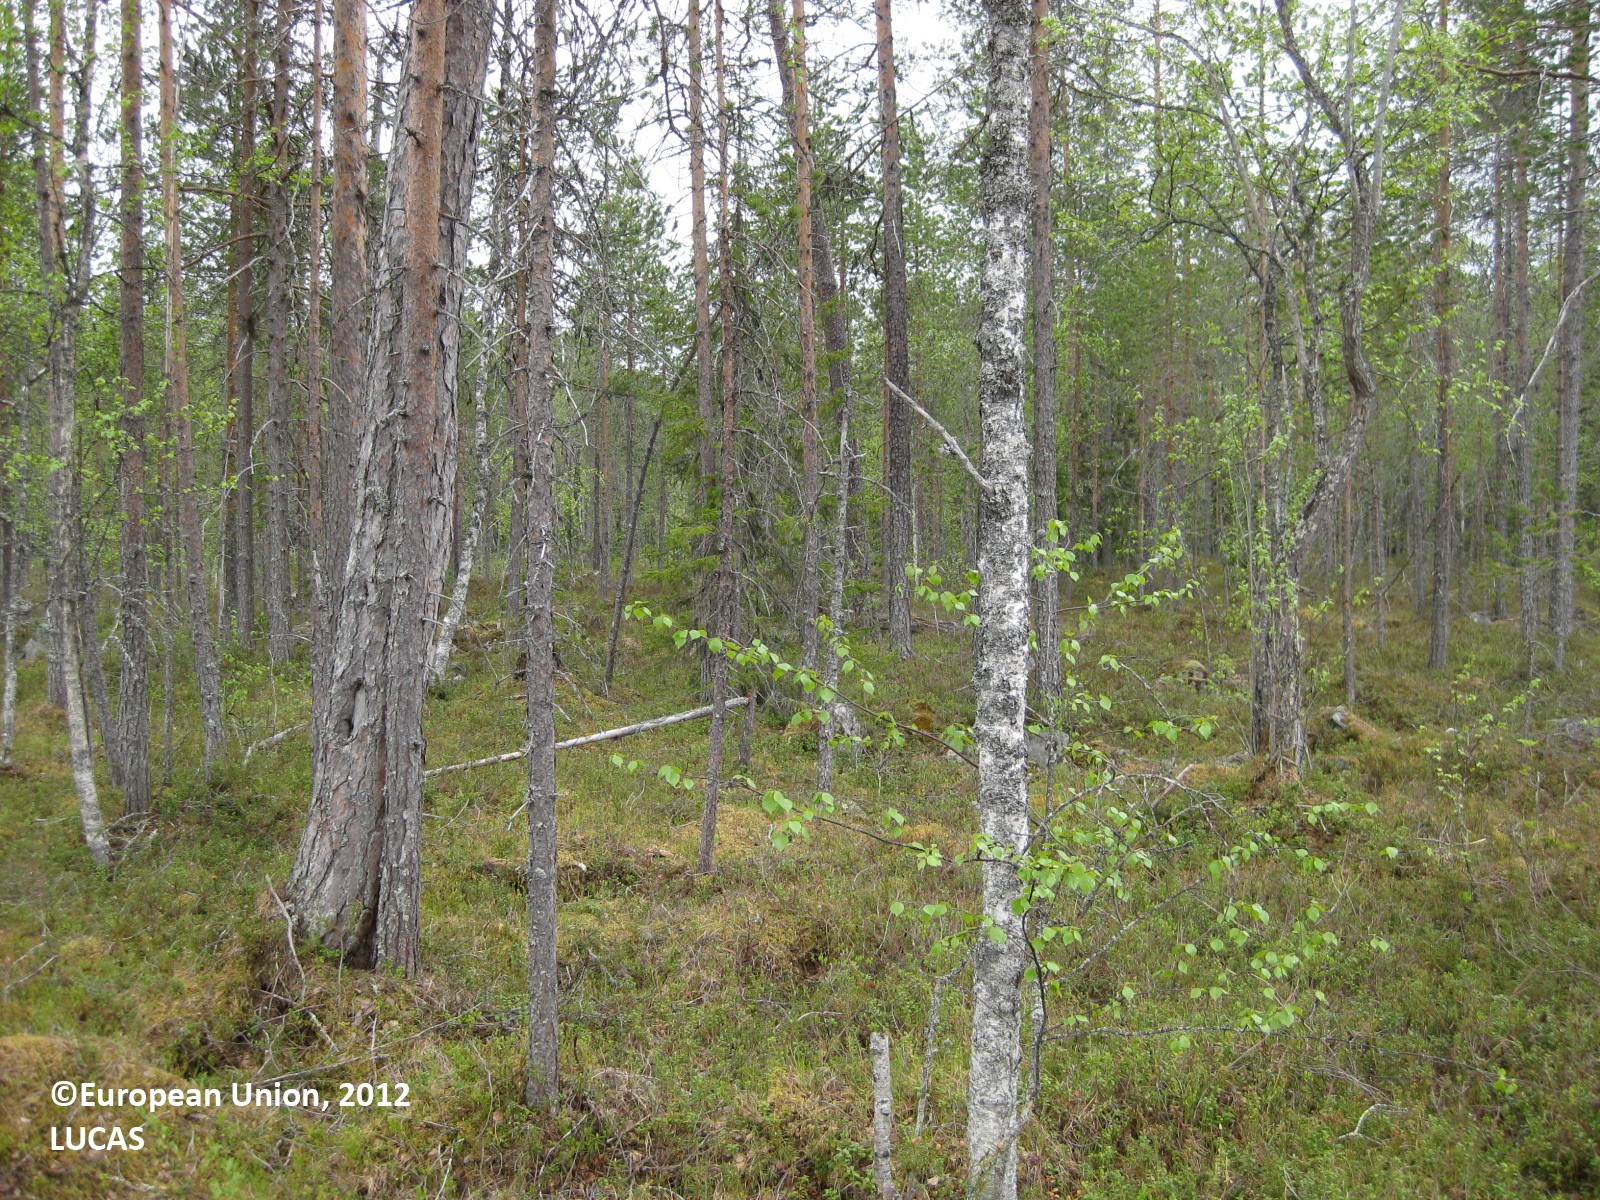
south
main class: Woodland
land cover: Pine dominated mixed woodland
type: boreal forest
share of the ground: 50 - 75 %
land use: Forestry
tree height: > 5 m
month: June
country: FI
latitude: 65.2120
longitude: 29.1944
